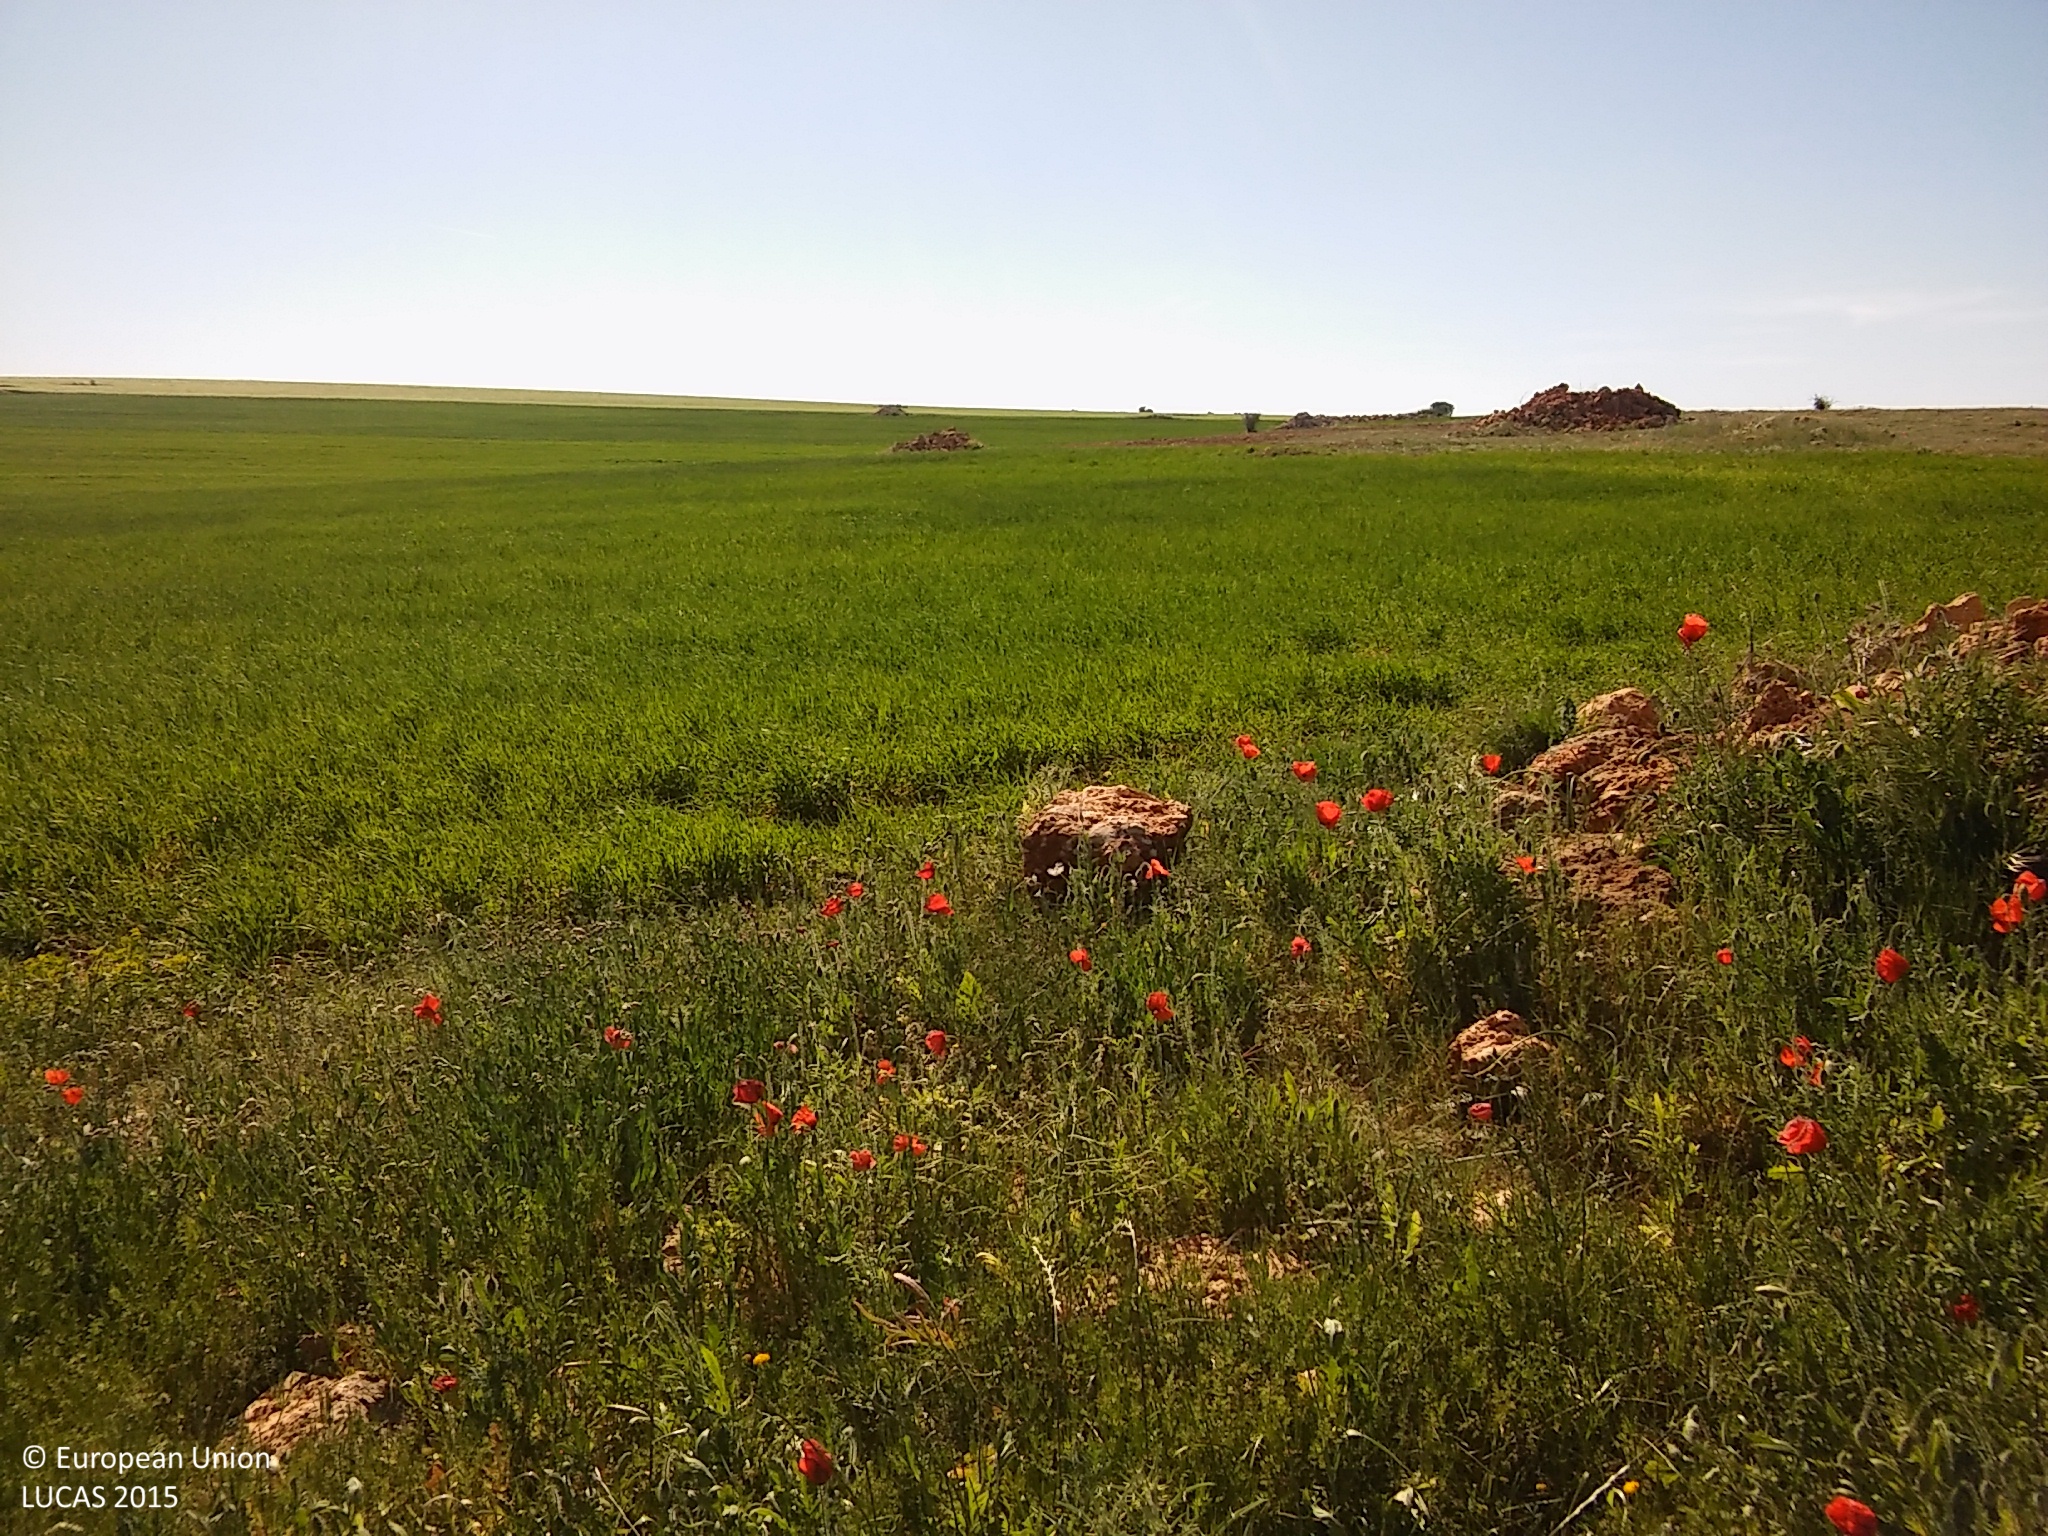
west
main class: Cropland
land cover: Barley
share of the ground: > 75 %
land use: Agriculture (excluding fallow land and kitchen gardens)
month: May
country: ES
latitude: 41.3830
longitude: -3.7420
